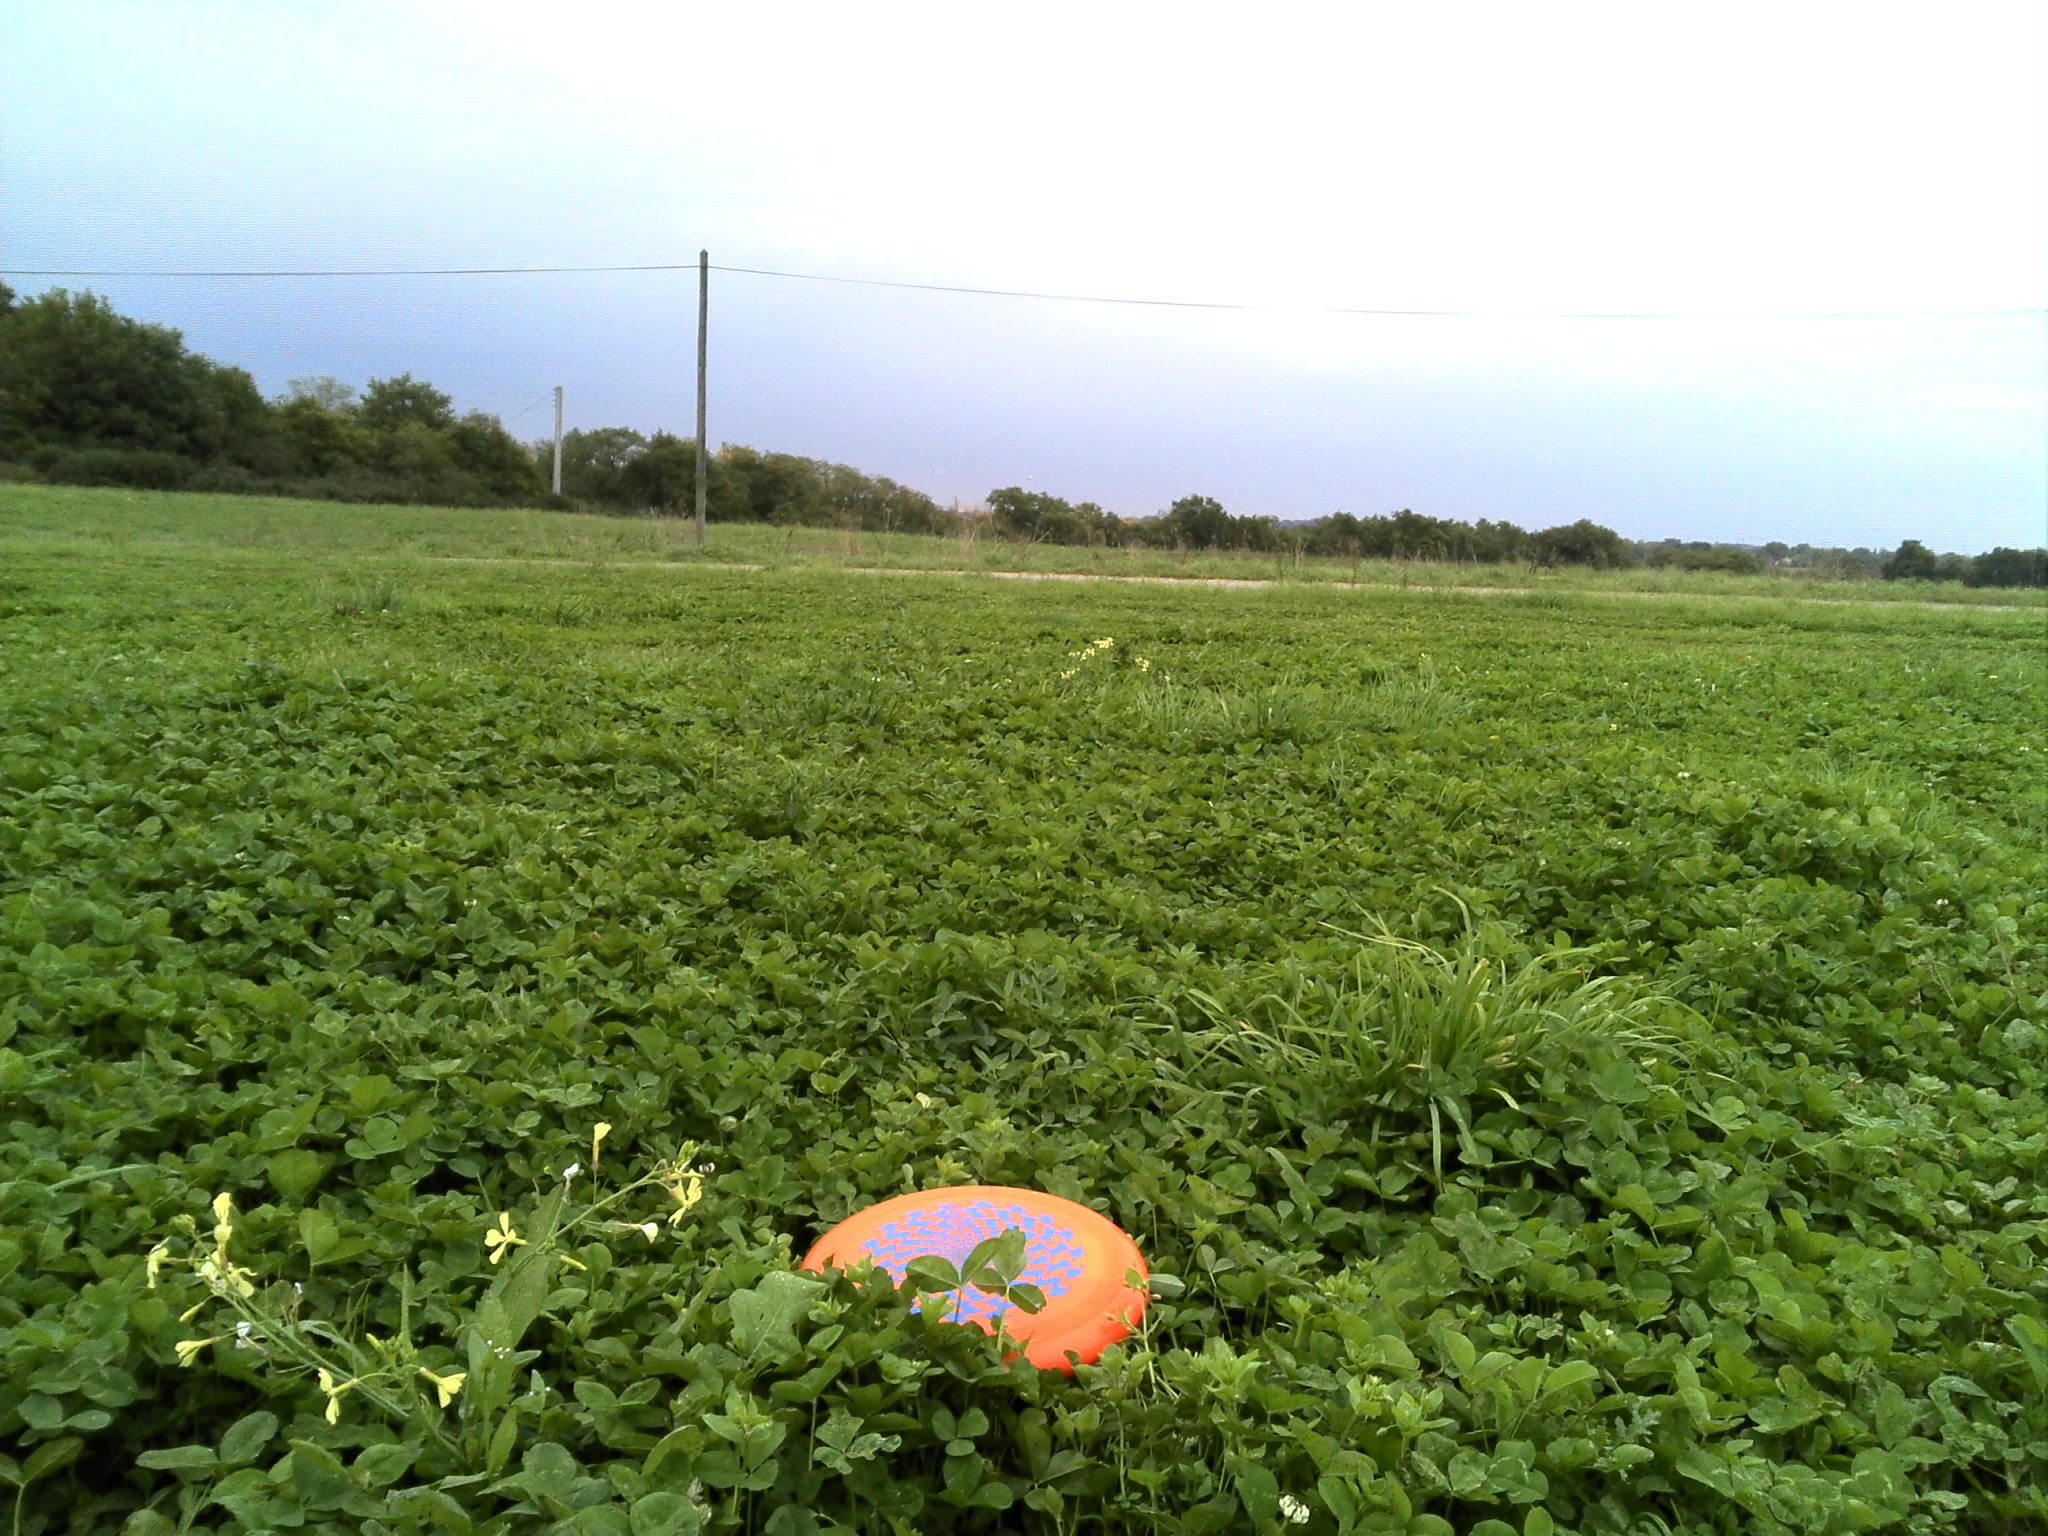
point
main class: Cropland
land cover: Clovers
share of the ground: > 75 %
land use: Agriculture (excluding fallow land and kitchen gardens)
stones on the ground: 10 - 25 %
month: October
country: FR
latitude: 47.2632
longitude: -1.2591
